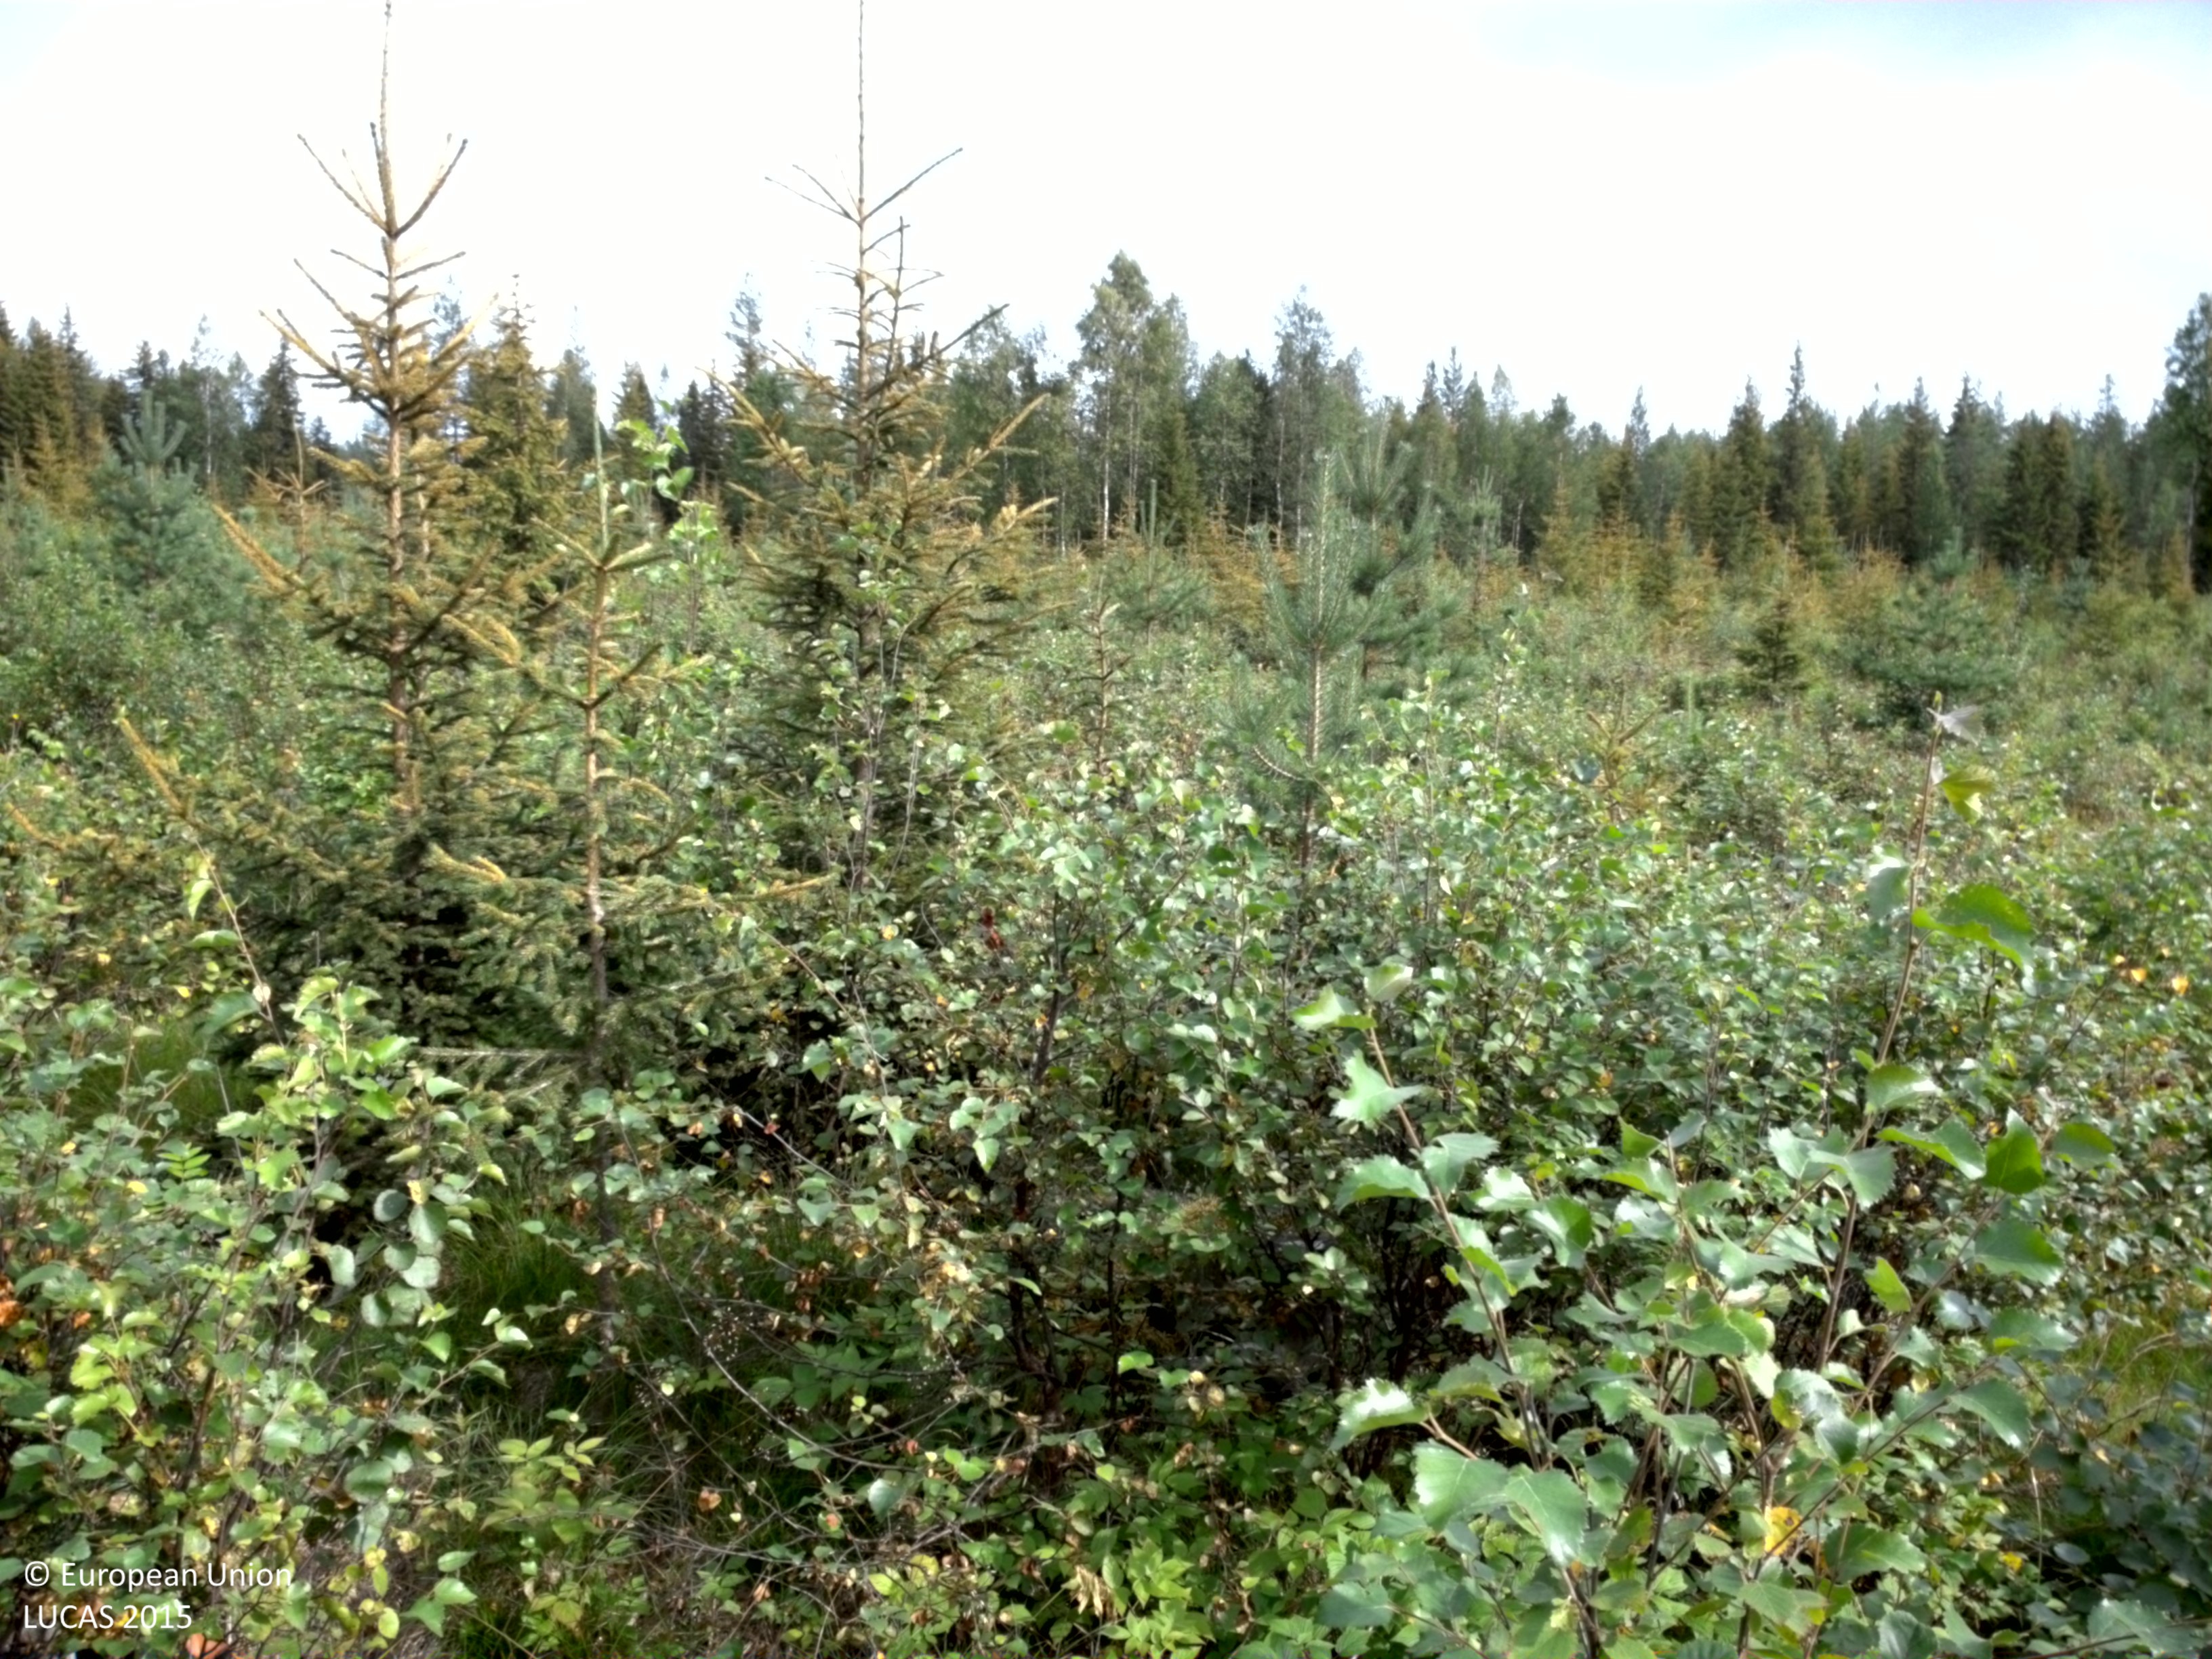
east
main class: Woodland
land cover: Other mixed woodland
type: boreal forest
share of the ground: 50 - 75 %
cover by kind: broadleaved forest trees 35 %, shrubs 35 %, coniferous forest trees 15 %, herbaceous plants 15 %
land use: Forestry
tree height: < 5 m
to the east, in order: Other mixed woodland; Spruce dominated coniferous woodland; Pine dominated coniferous woodland
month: August
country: SE
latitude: 65.9830
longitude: 22.6408
